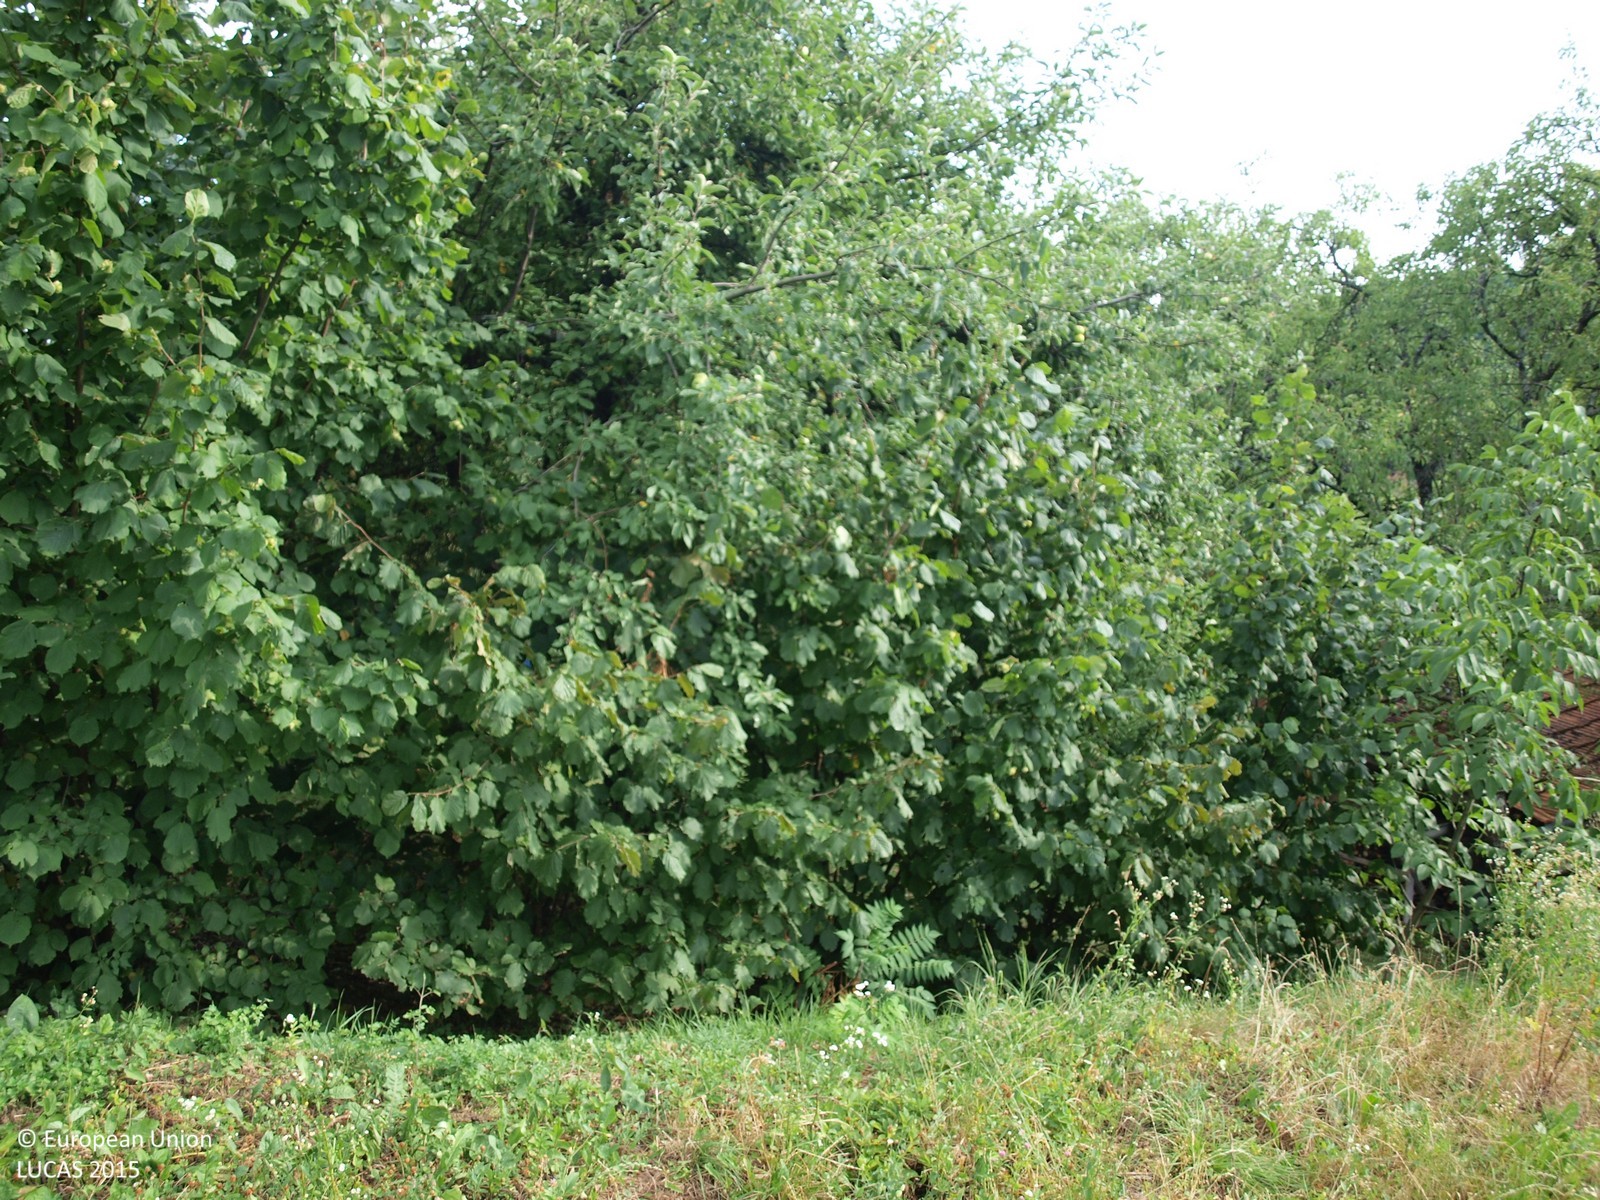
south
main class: Grassland
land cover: Grassland with sparse tree/shrub cover
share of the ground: > 75 %
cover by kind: herbaceous plants 95 %, broadleaved forest trees 5 %
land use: Agriculture (excluding fallow land and kitchen gardens)
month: July
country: HR
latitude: 45.9378
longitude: 16.1768
